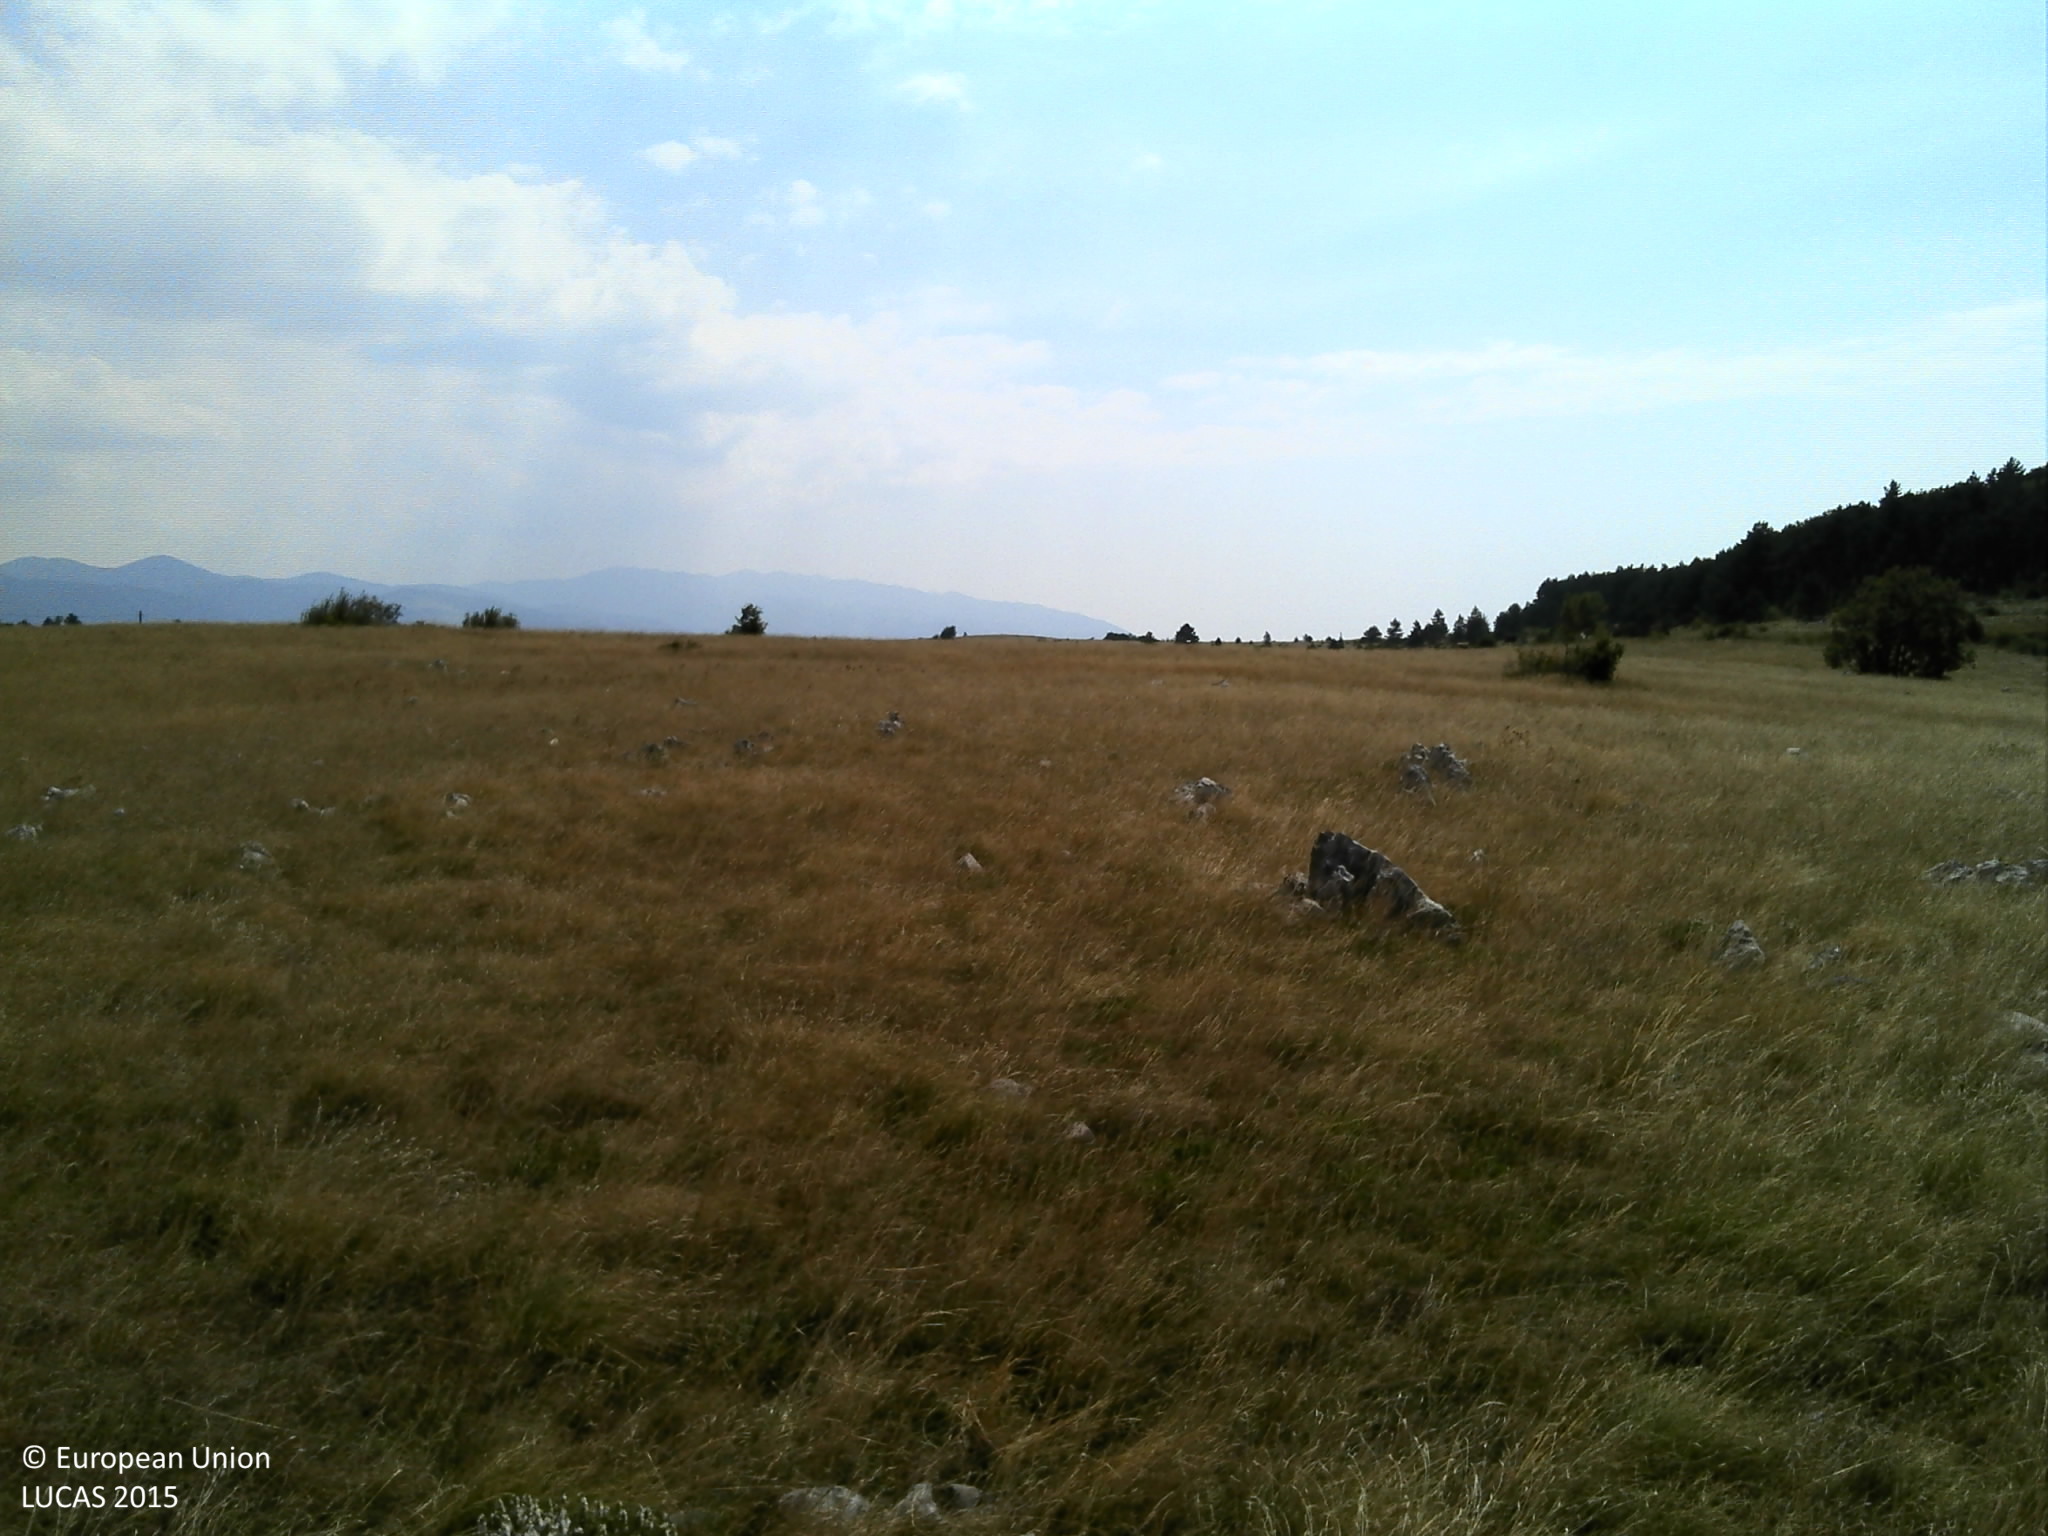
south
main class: Grassland
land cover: Grassland without tree/shrub cover
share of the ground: > 75 %
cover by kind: herbaceous plants 90 %, consolidated bare surface 5 %, unconsolidated bare surface 5 %
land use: Semi-natural and natural areas not in use
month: August
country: HR
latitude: 45.0281
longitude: 14.9316
